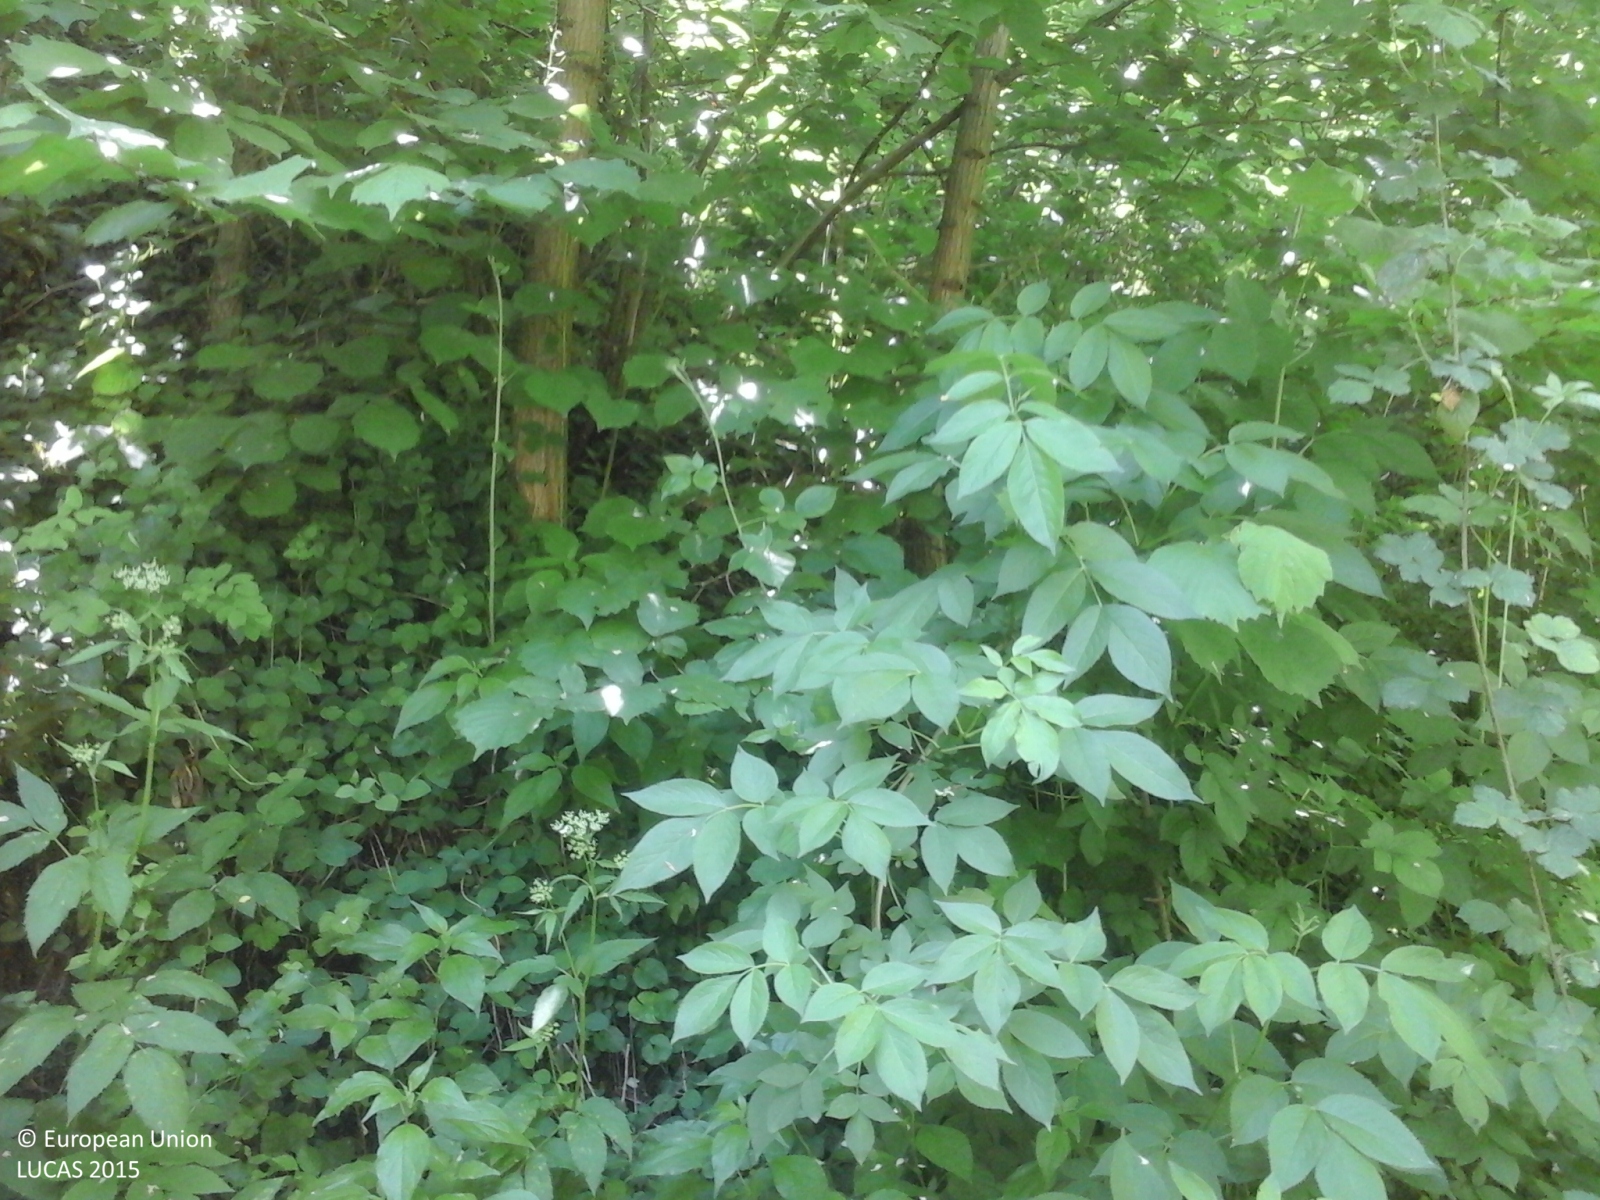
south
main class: Woodland
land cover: Broadleaved woodland
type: thermophilous deciduous forest
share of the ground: > 75 %
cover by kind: broadleaved forest trees 100 %
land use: Forestry
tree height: > 5 m
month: May
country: IT
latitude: 44.1650
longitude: 11.0355
